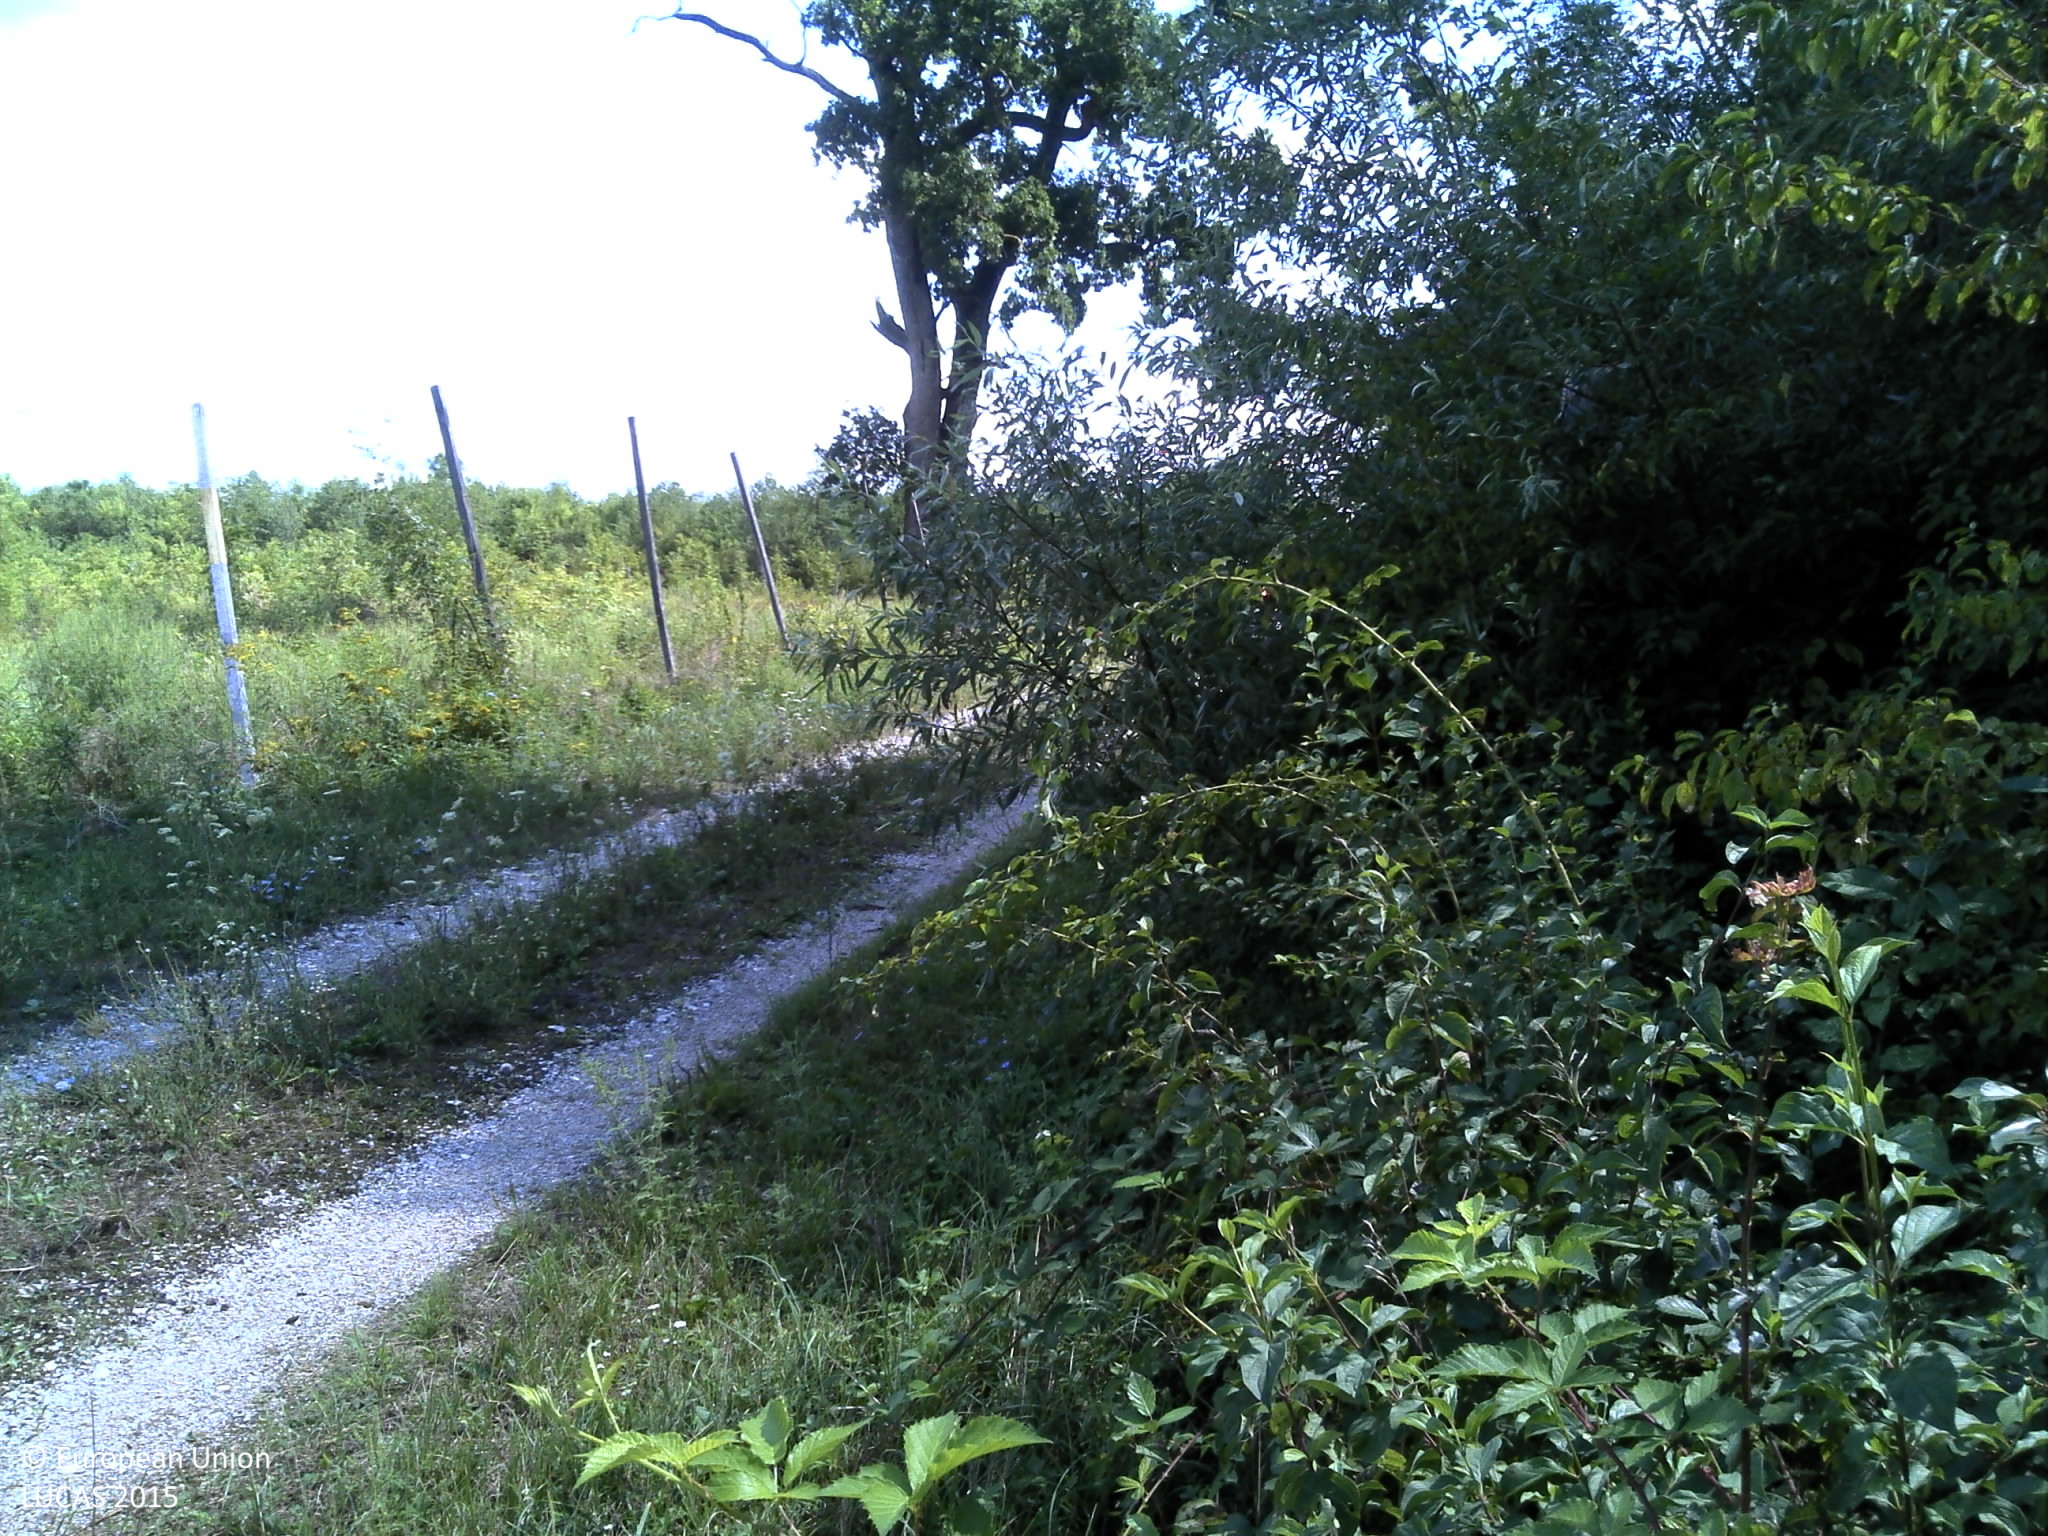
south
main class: Woodland
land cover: Broadleaved woodland
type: mesophytic deciduous forest
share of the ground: > 75 %
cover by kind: broadleaved forest trees 100 %
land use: Forestry
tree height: > 5 m
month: August
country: HR
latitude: 45.5673
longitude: 15.6984
